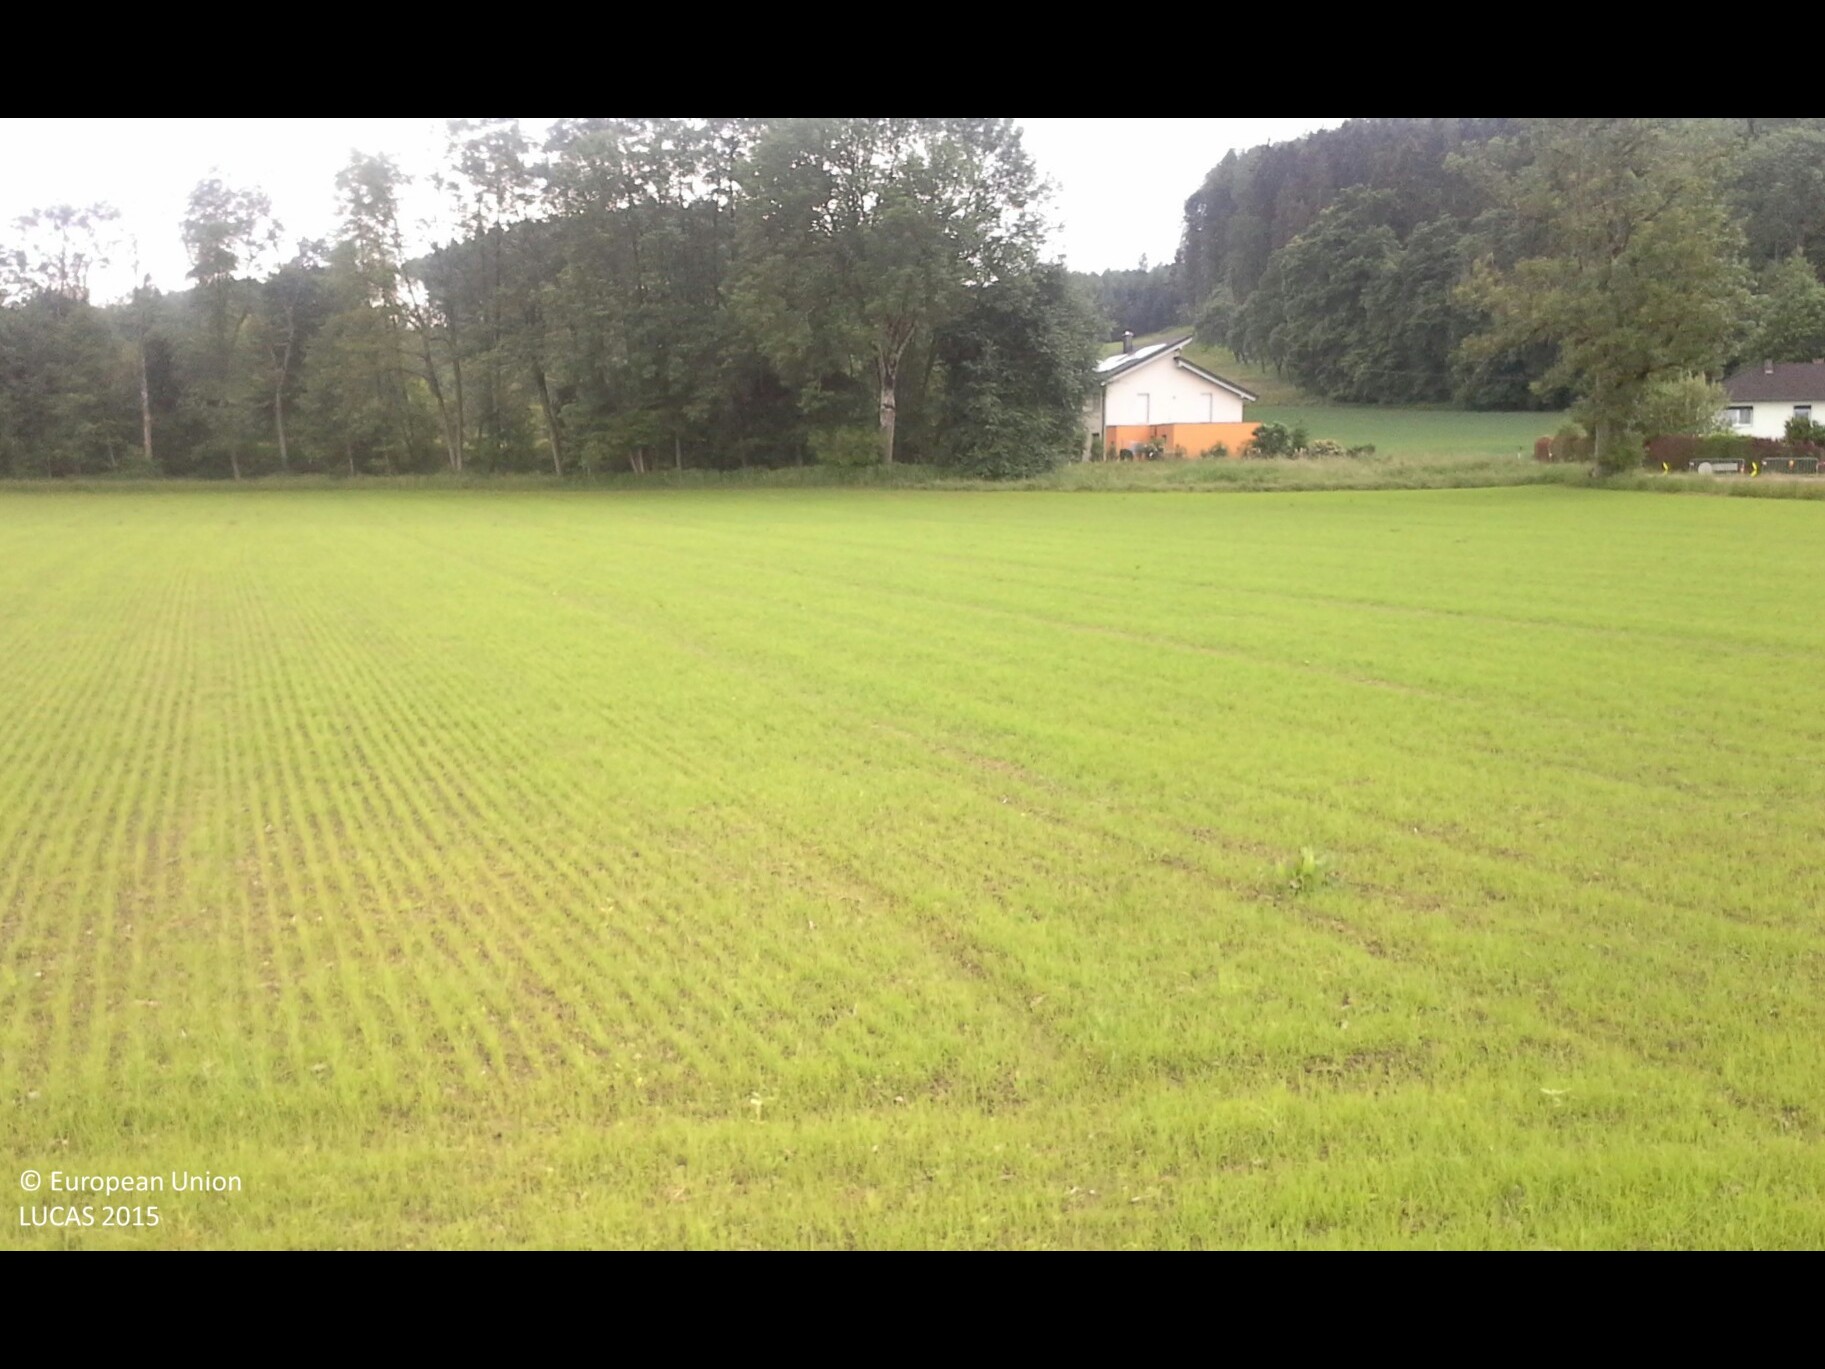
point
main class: Cropland
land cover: Temporary grasslands
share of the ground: > 75 %
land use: Agriculture (excluding fallow land and kitchen gardens)
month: May
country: AT
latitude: 48.0810
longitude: 14.4164
